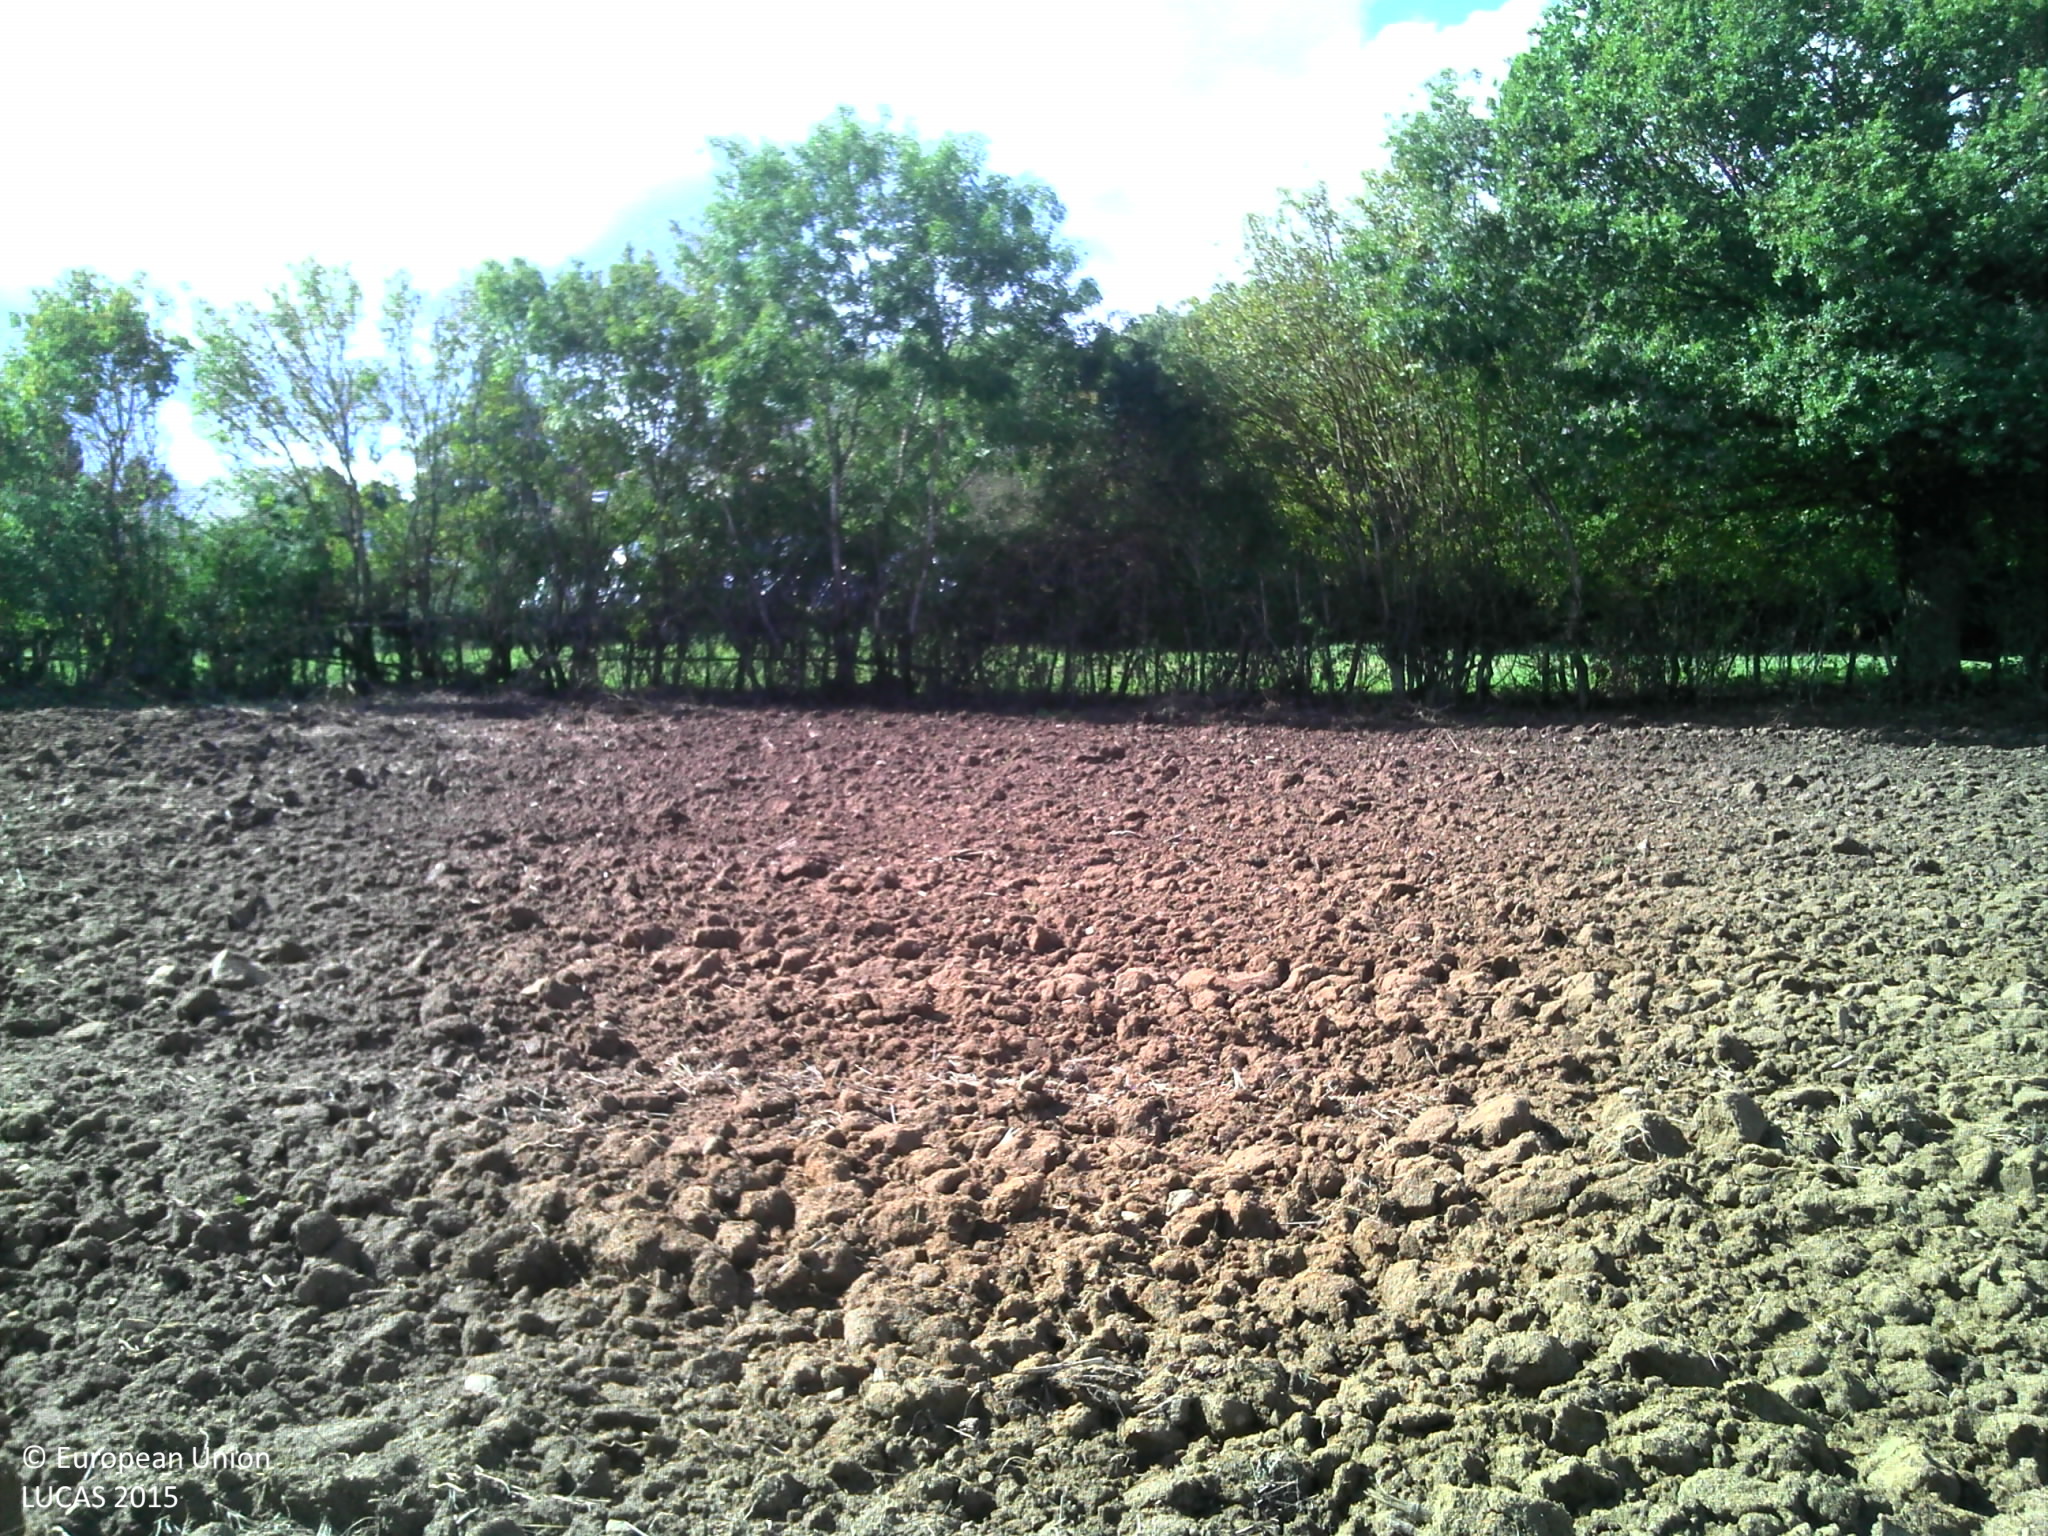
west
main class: Grassland
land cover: Spontaneously vegetated surfaces
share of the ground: > 75 %
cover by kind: herbaceous plants 100 %
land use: Agriculture (excluding fallow land and kitchen gardens)
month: September
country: FR
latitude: 47.1940
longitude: 4.3371
